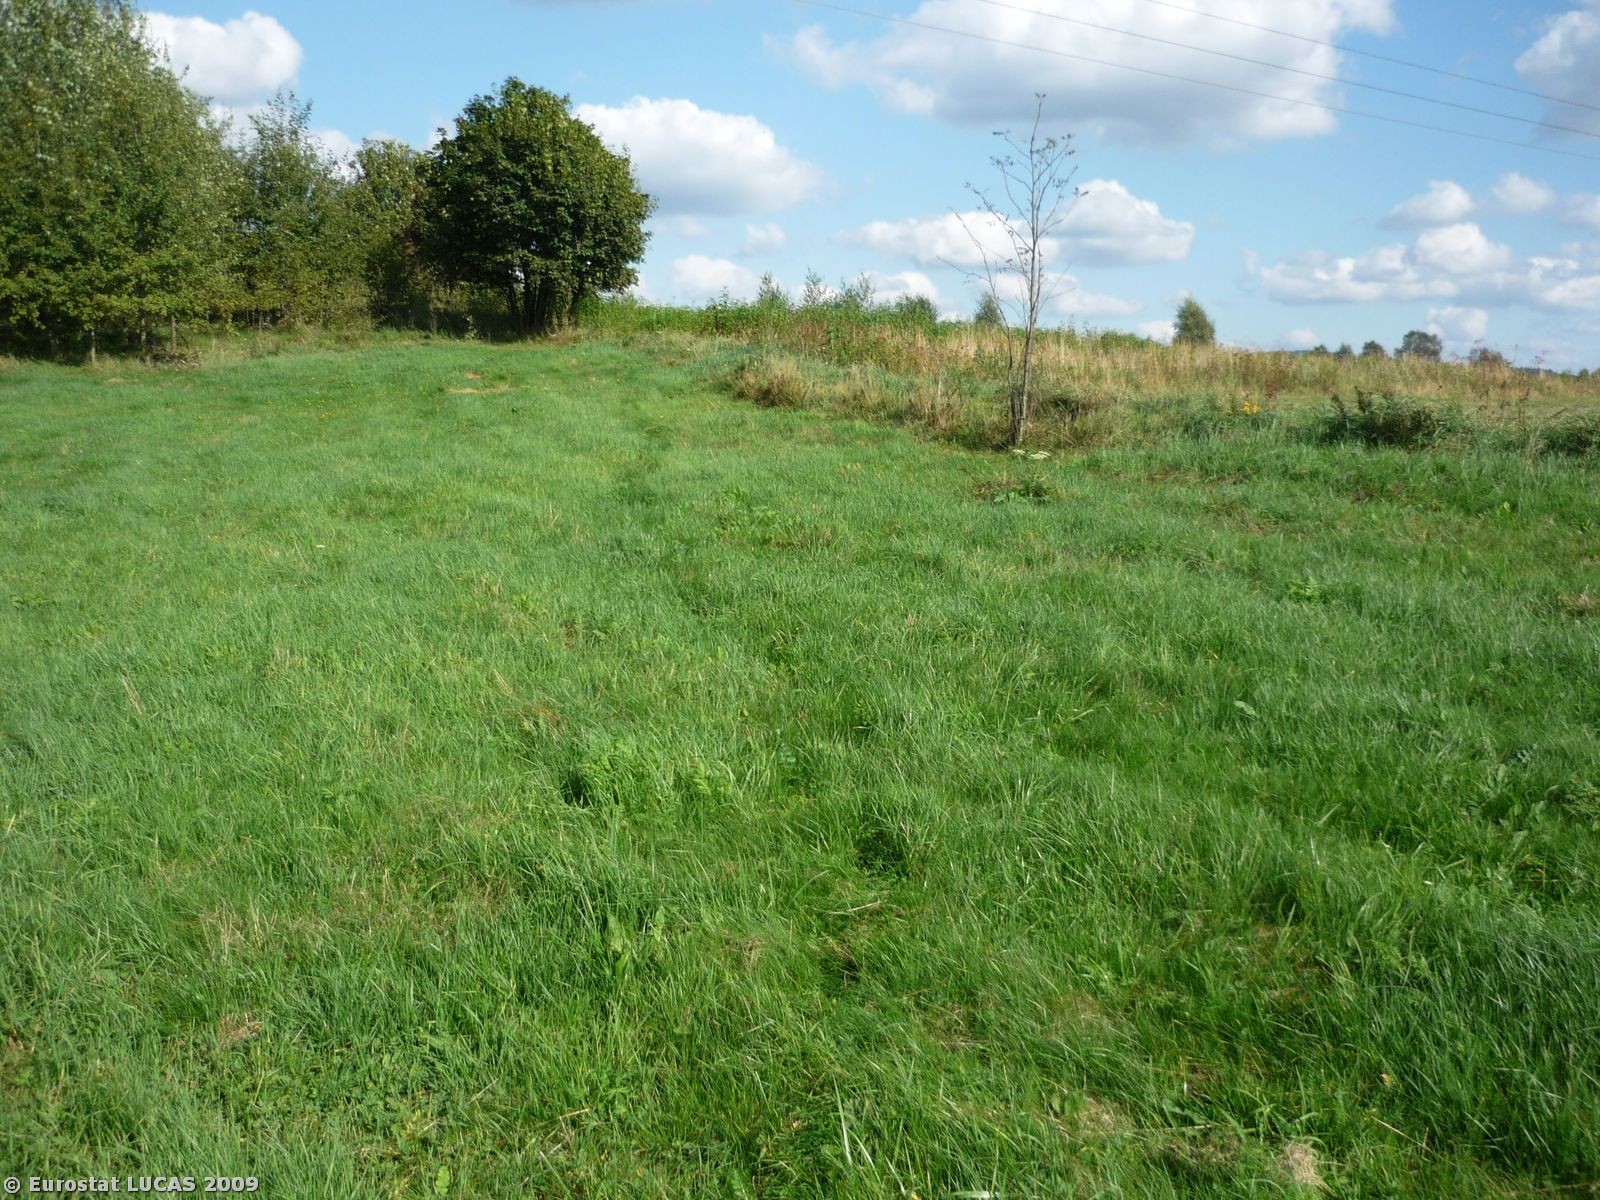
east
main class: Grassland
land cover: Grassland without tree/shrub cover
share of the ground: > 75 %
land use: Agriculture (excluding fallow land and kitchen gardens)
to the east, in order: Grassland without tree/shrub cover; Grassland with sparse tree/shrub cover; Oats; Electric lines; Paved roads, cycling and walking lanes; Grassland with sparse tree/shrub cover
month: September
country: PL
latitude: 50.7251
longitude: 16.0833
